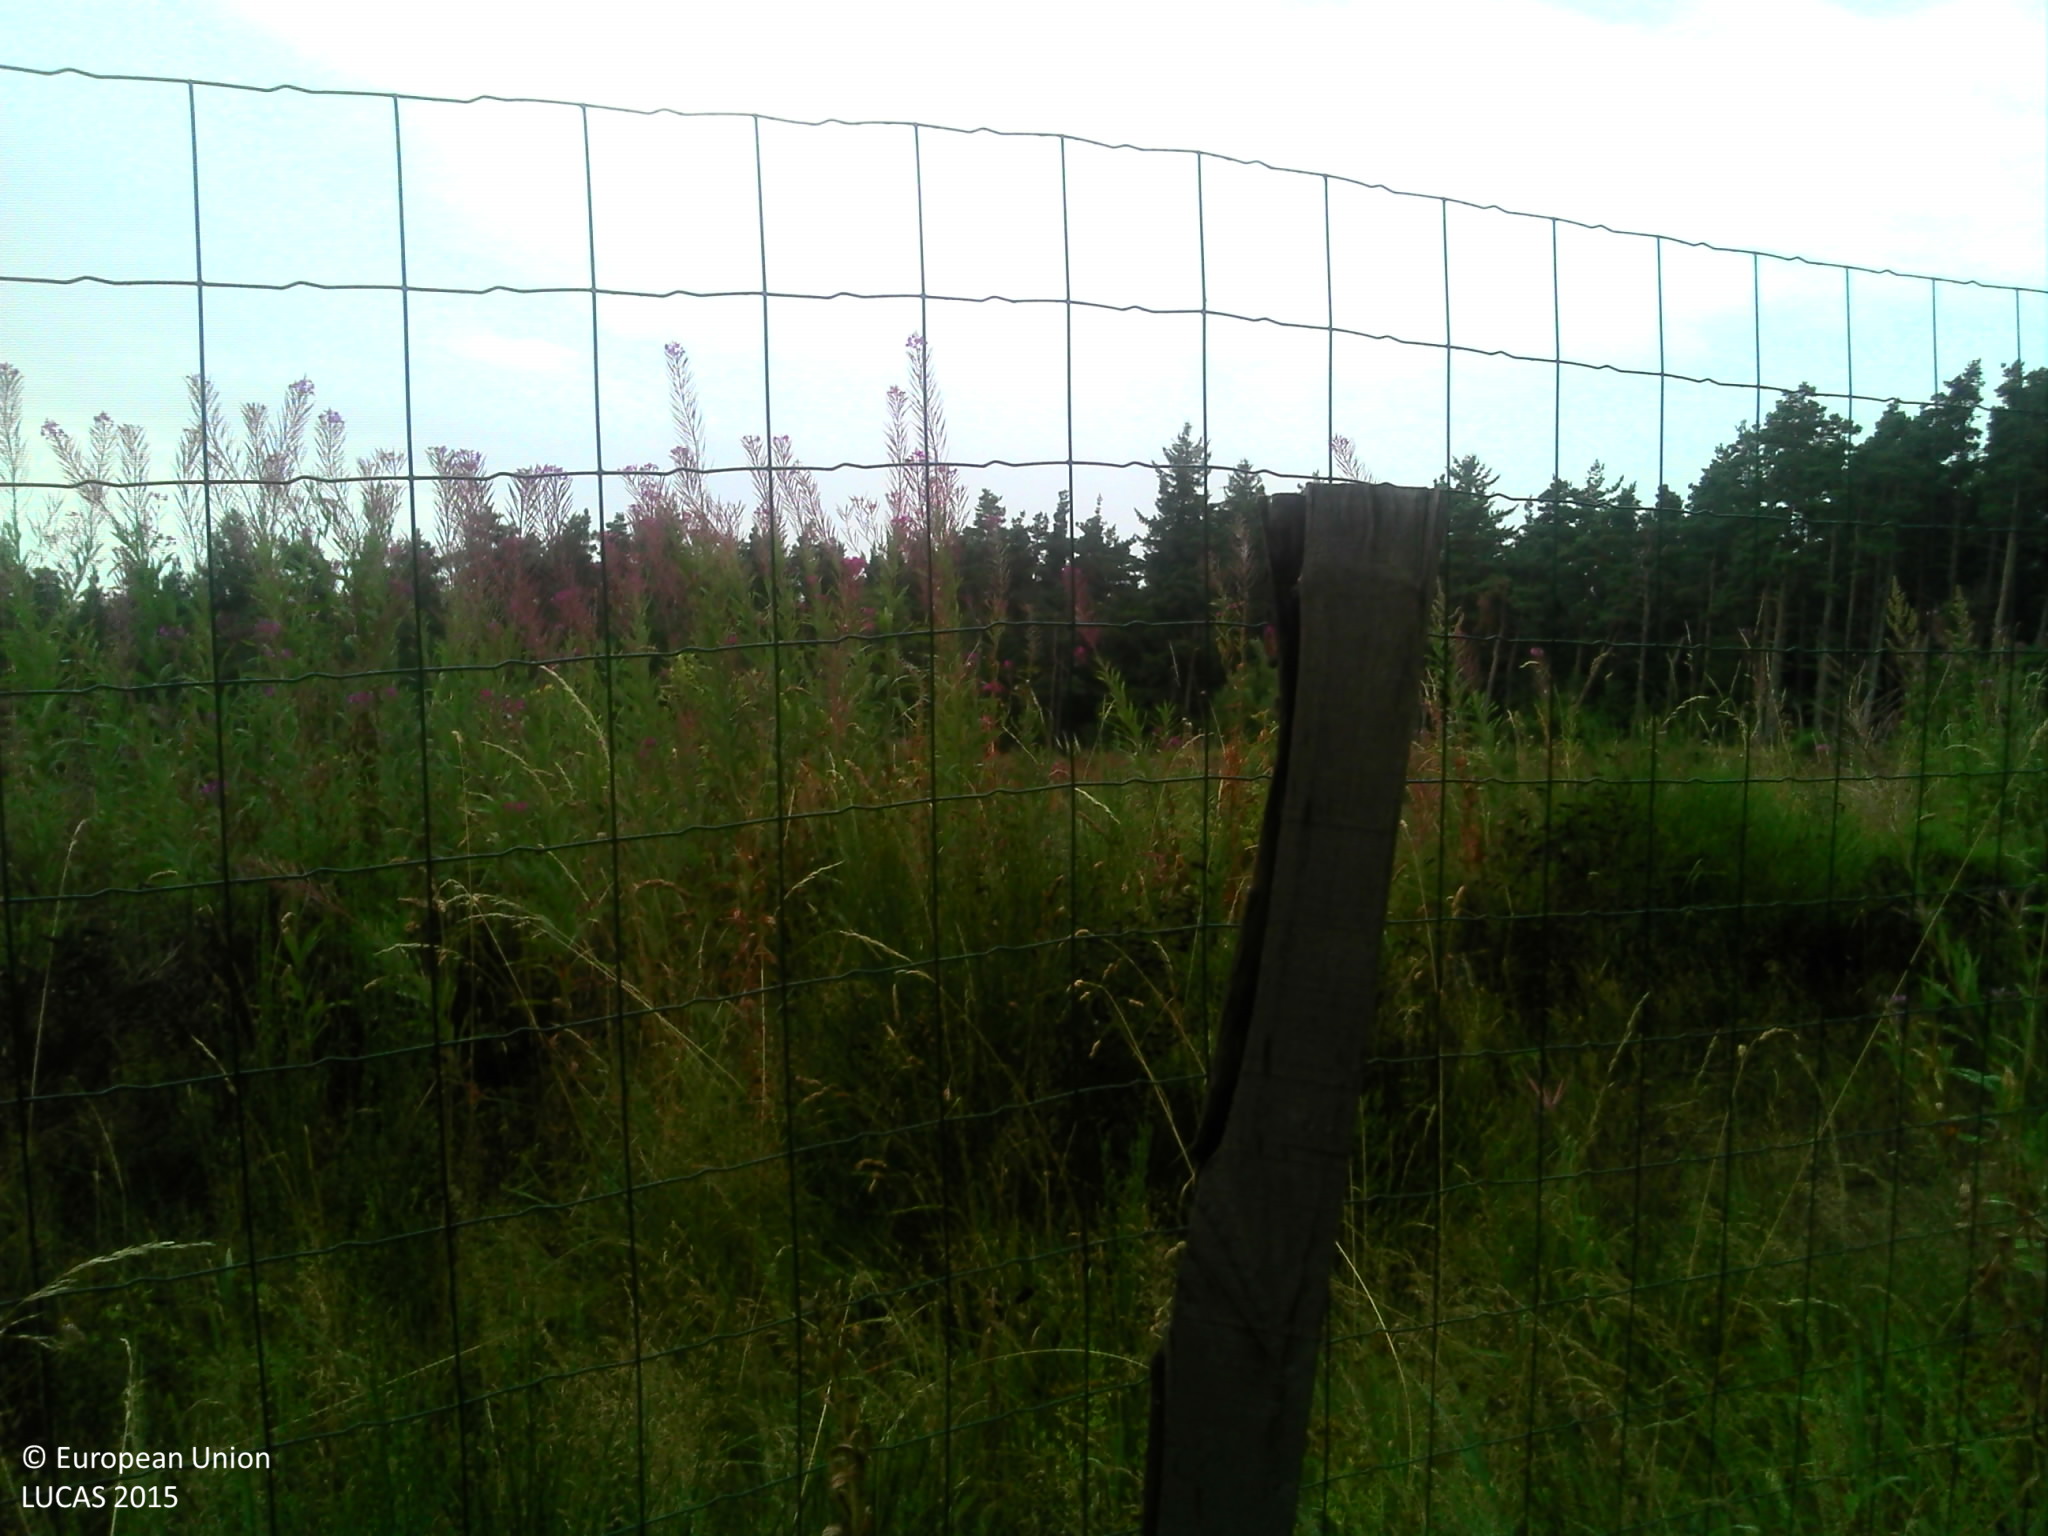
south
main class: Woodland
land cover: Pine dominated mixed woodland
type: mesophytic deciduous forest
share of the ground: > 75 %
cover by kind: broadleaved forest trees 45 %, coniferous forest trees 35 %, shrubs 10 %, herbaceous plants 10 %
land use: Forestry
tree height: < 5 m
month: August
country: FR
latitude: 45.0366
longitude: 4.1781
